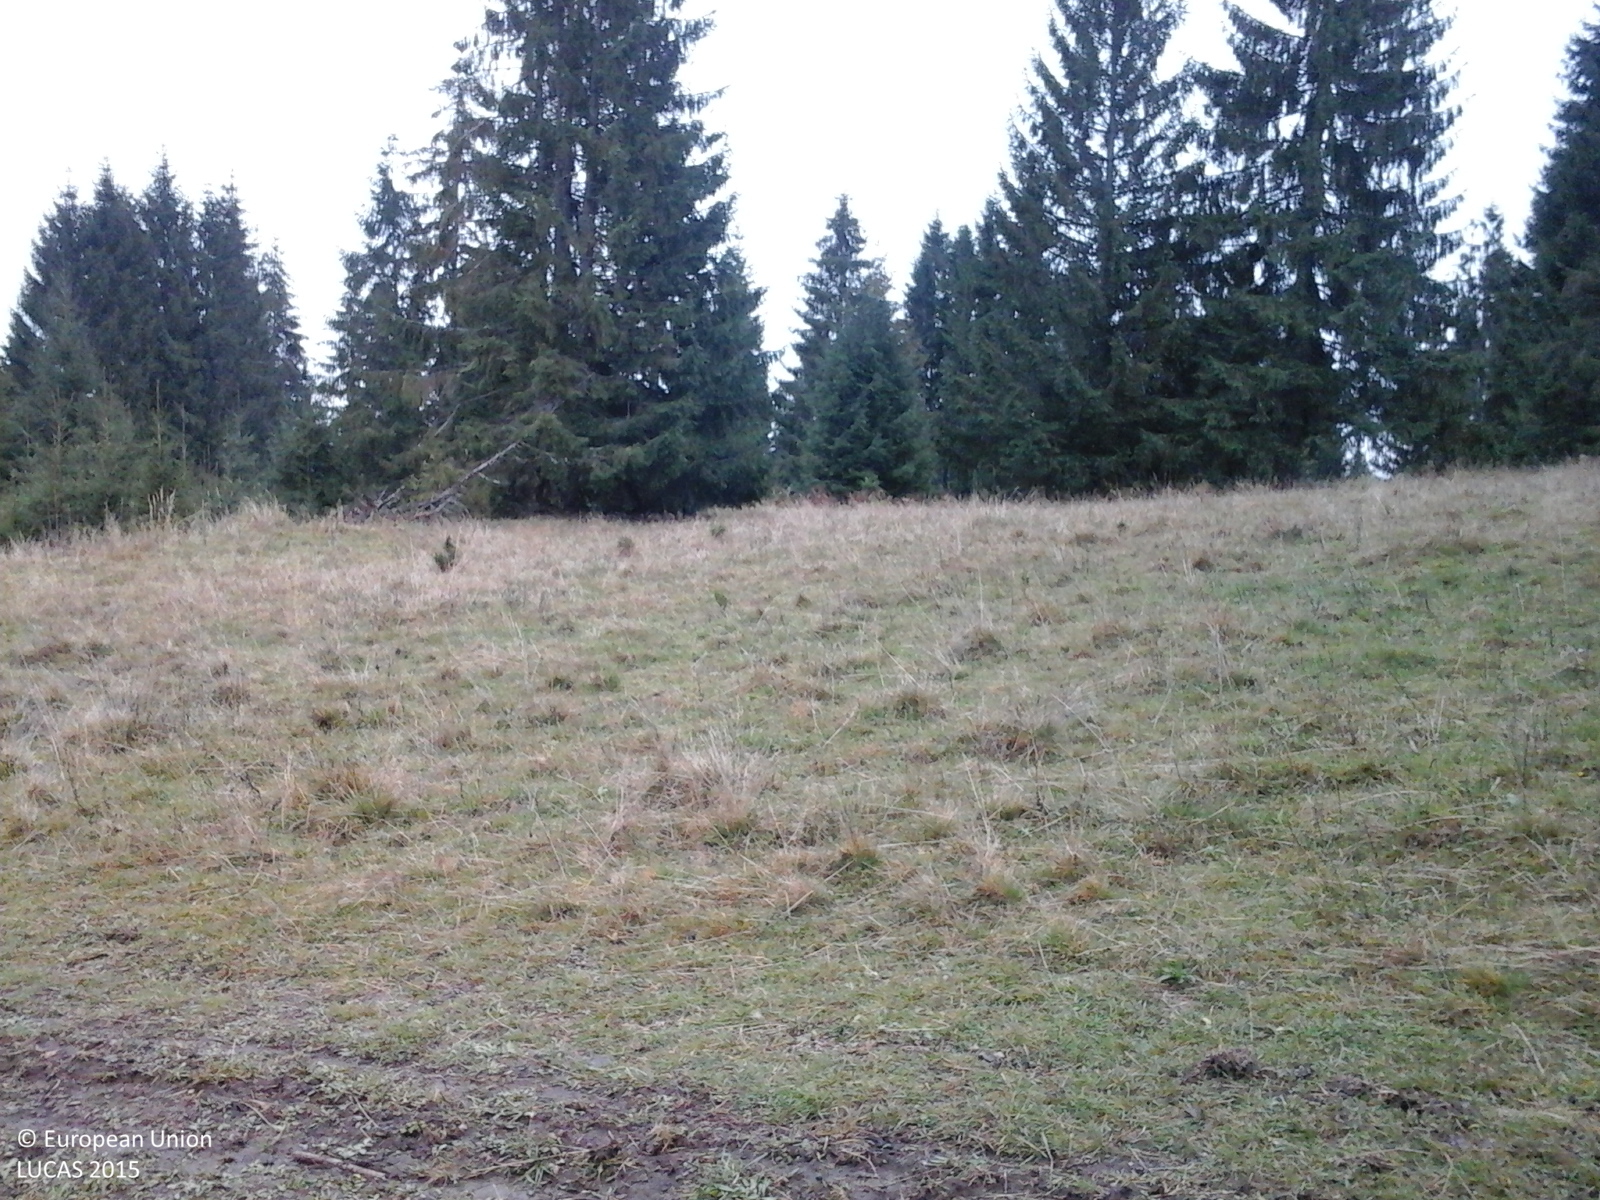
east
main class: Grassland
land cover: Grassland with sparse tree/shrub cover
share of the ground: > 75 %
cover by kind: herbaceous plants 95 %, coniferous forest trees 5 %
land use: Agriculture (excluding fallow land and kitchen gardens)
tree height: > 5 m
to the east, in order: Grassland with sparse tree/shrub cover; Tracks; Grassland with sparse tree/shrub cover; Spruce dominated coniferous woodland
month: October
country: RO
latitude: 46.9345
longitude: 25.2510
